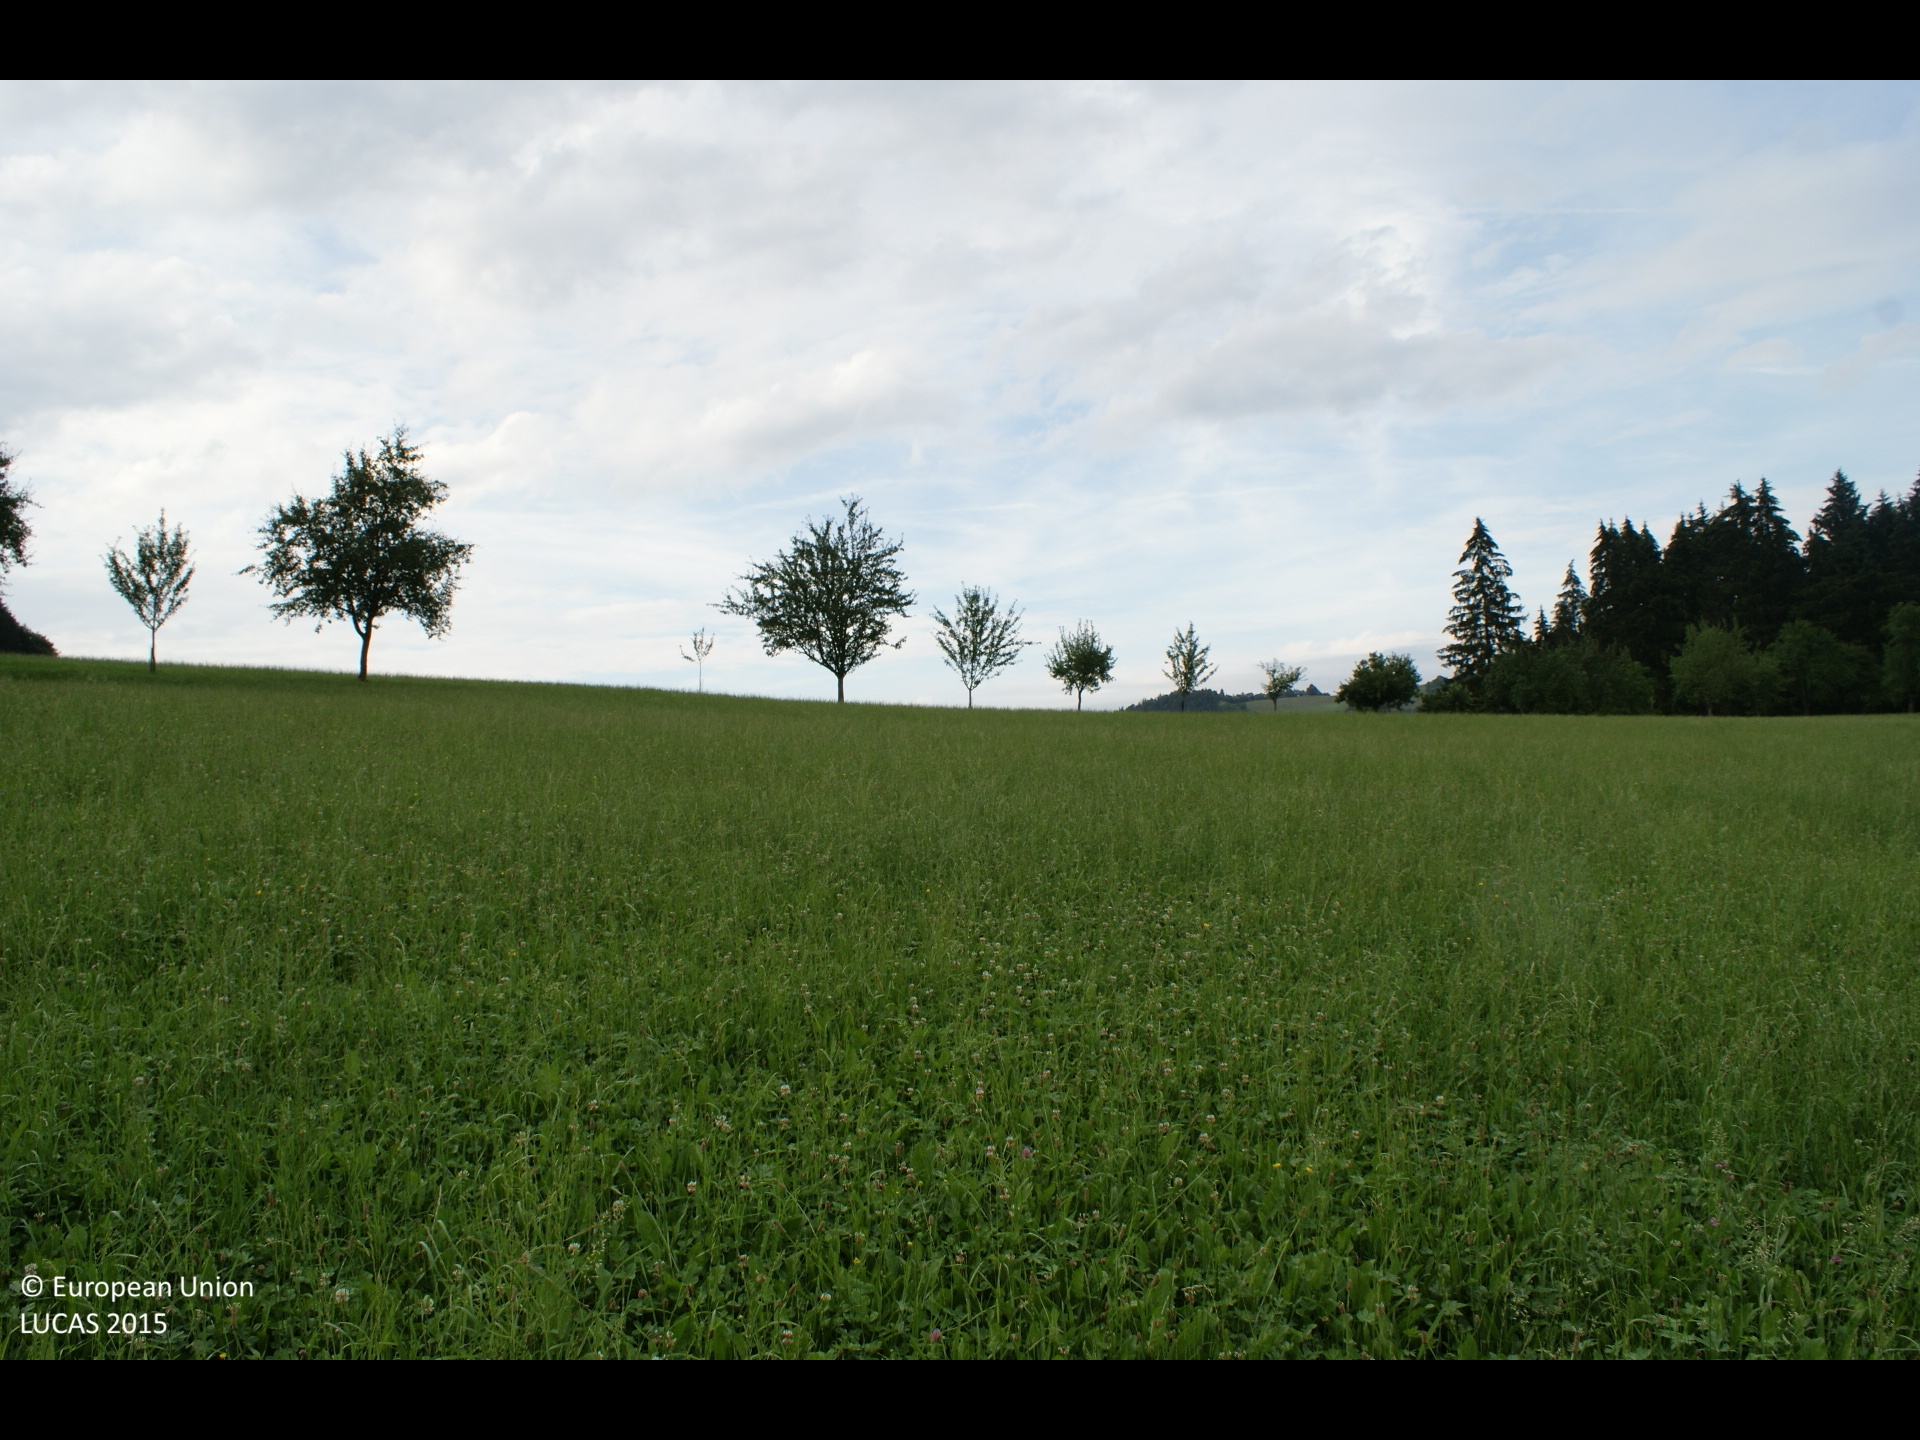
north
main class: Grassland
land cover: Grassland without tree/shrub cover
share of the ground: > 75 %
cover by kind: herbaceous plants 100 %
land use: Agriculture (excluding fallow land and kitchen gardens)
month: July
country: AT
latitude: 47.9469
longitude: 15.0216
